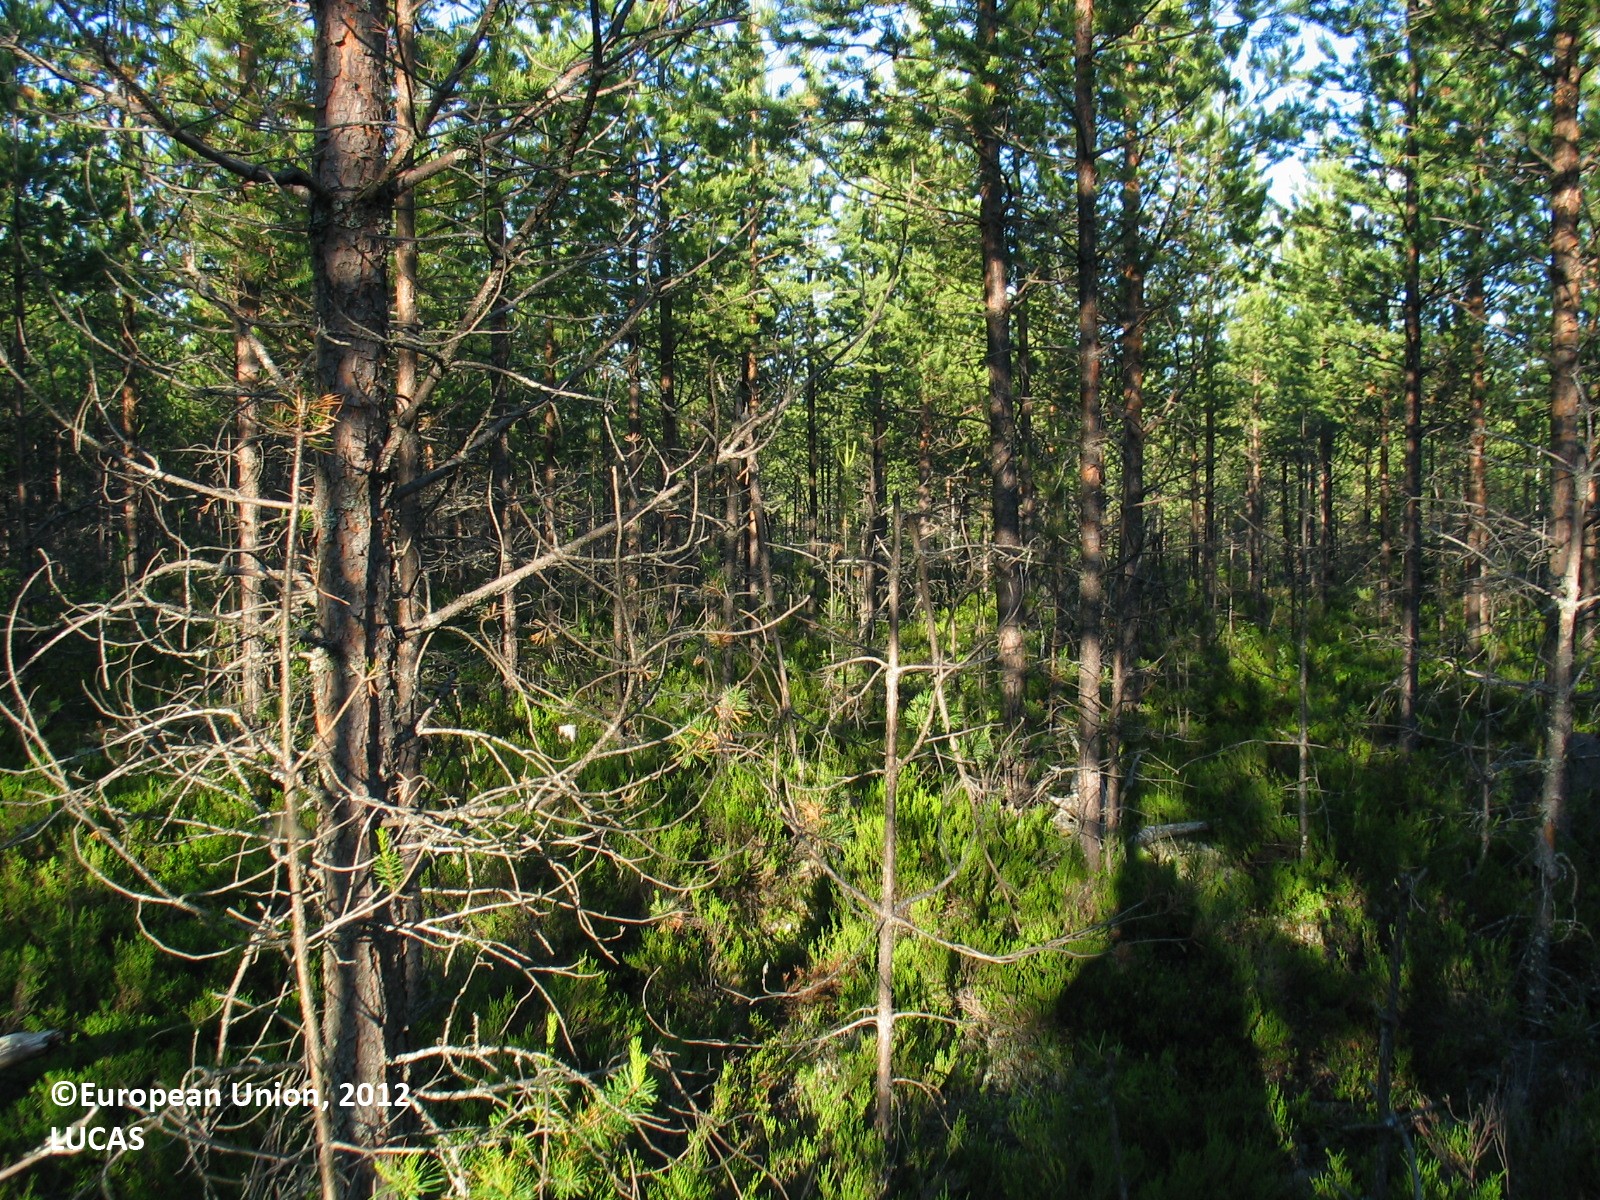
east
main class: Woodland
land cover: Pine dominated coniferous woodland
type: boreal forest
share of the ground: 25 - 50 %
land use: Forestry
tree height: > 5 m
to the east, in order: Pine dominated coniferous woodland; Ditches and canals; Groves; Tracks; Groves; Ditches and canals; Pine dominated coniferous woodland; Ditches and canals; Pine dominated coniferous woodland
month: July
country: FI
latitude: 64.7955
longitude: 26.5922
